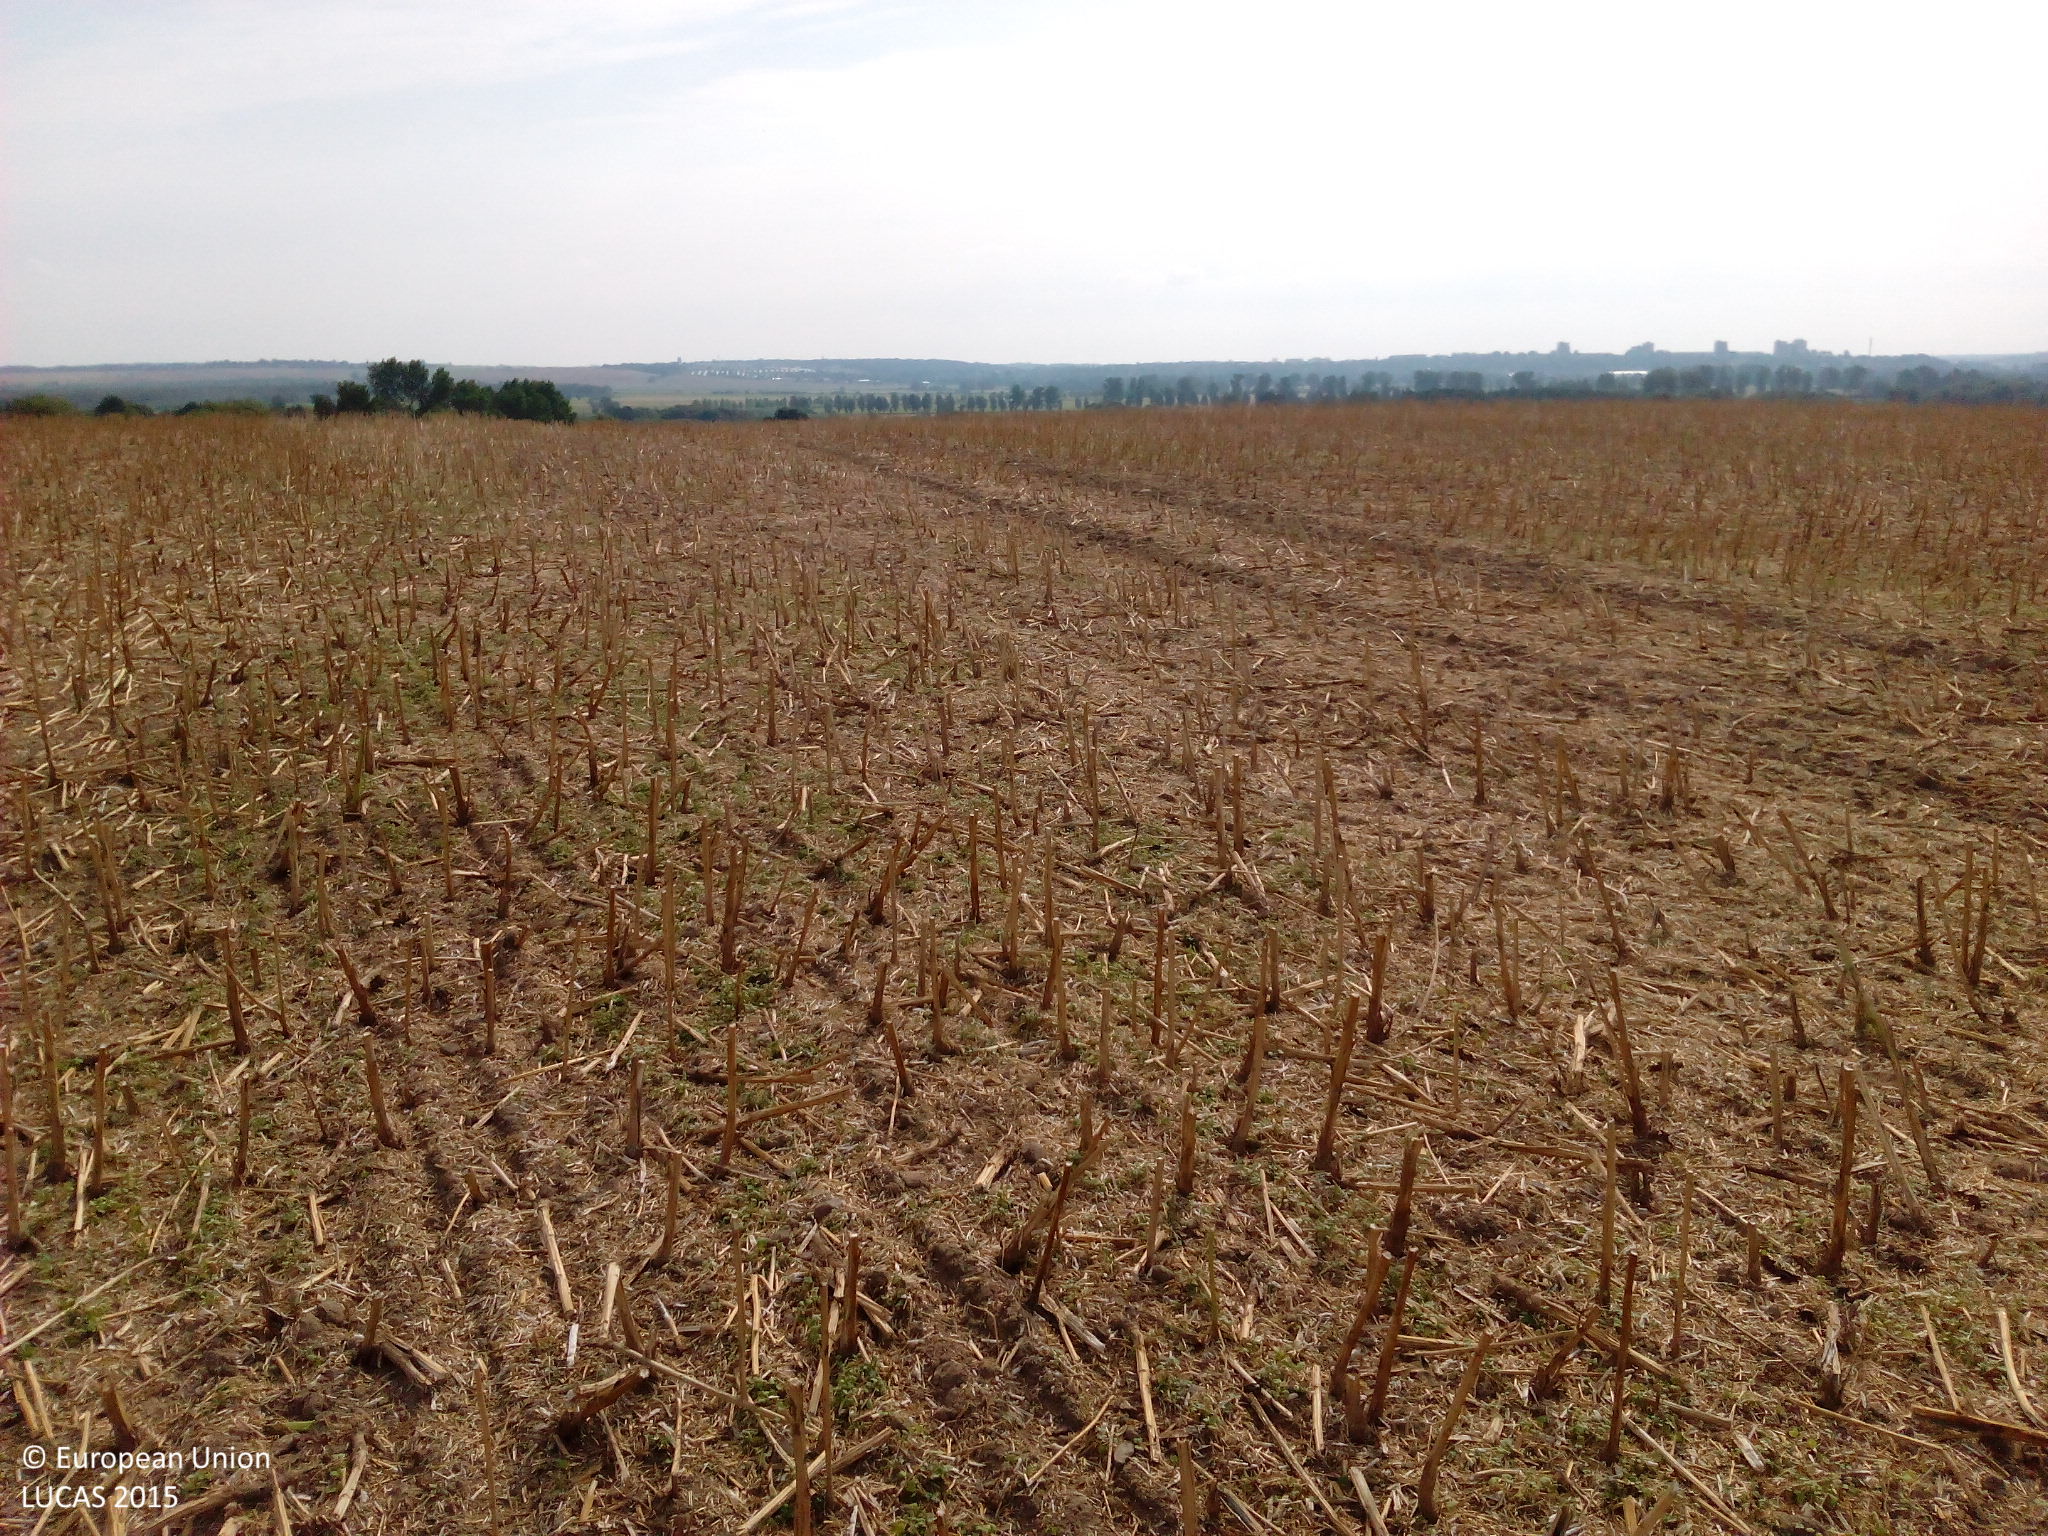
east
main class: Cropland
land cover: Rape and turnip rape
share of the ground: < 10 %
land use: Agriculture (excluding fallow land and kitchen gardens)
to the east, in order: Rape and turnip rape
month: August
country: DE
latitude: 53.5931
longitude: 13.2177
